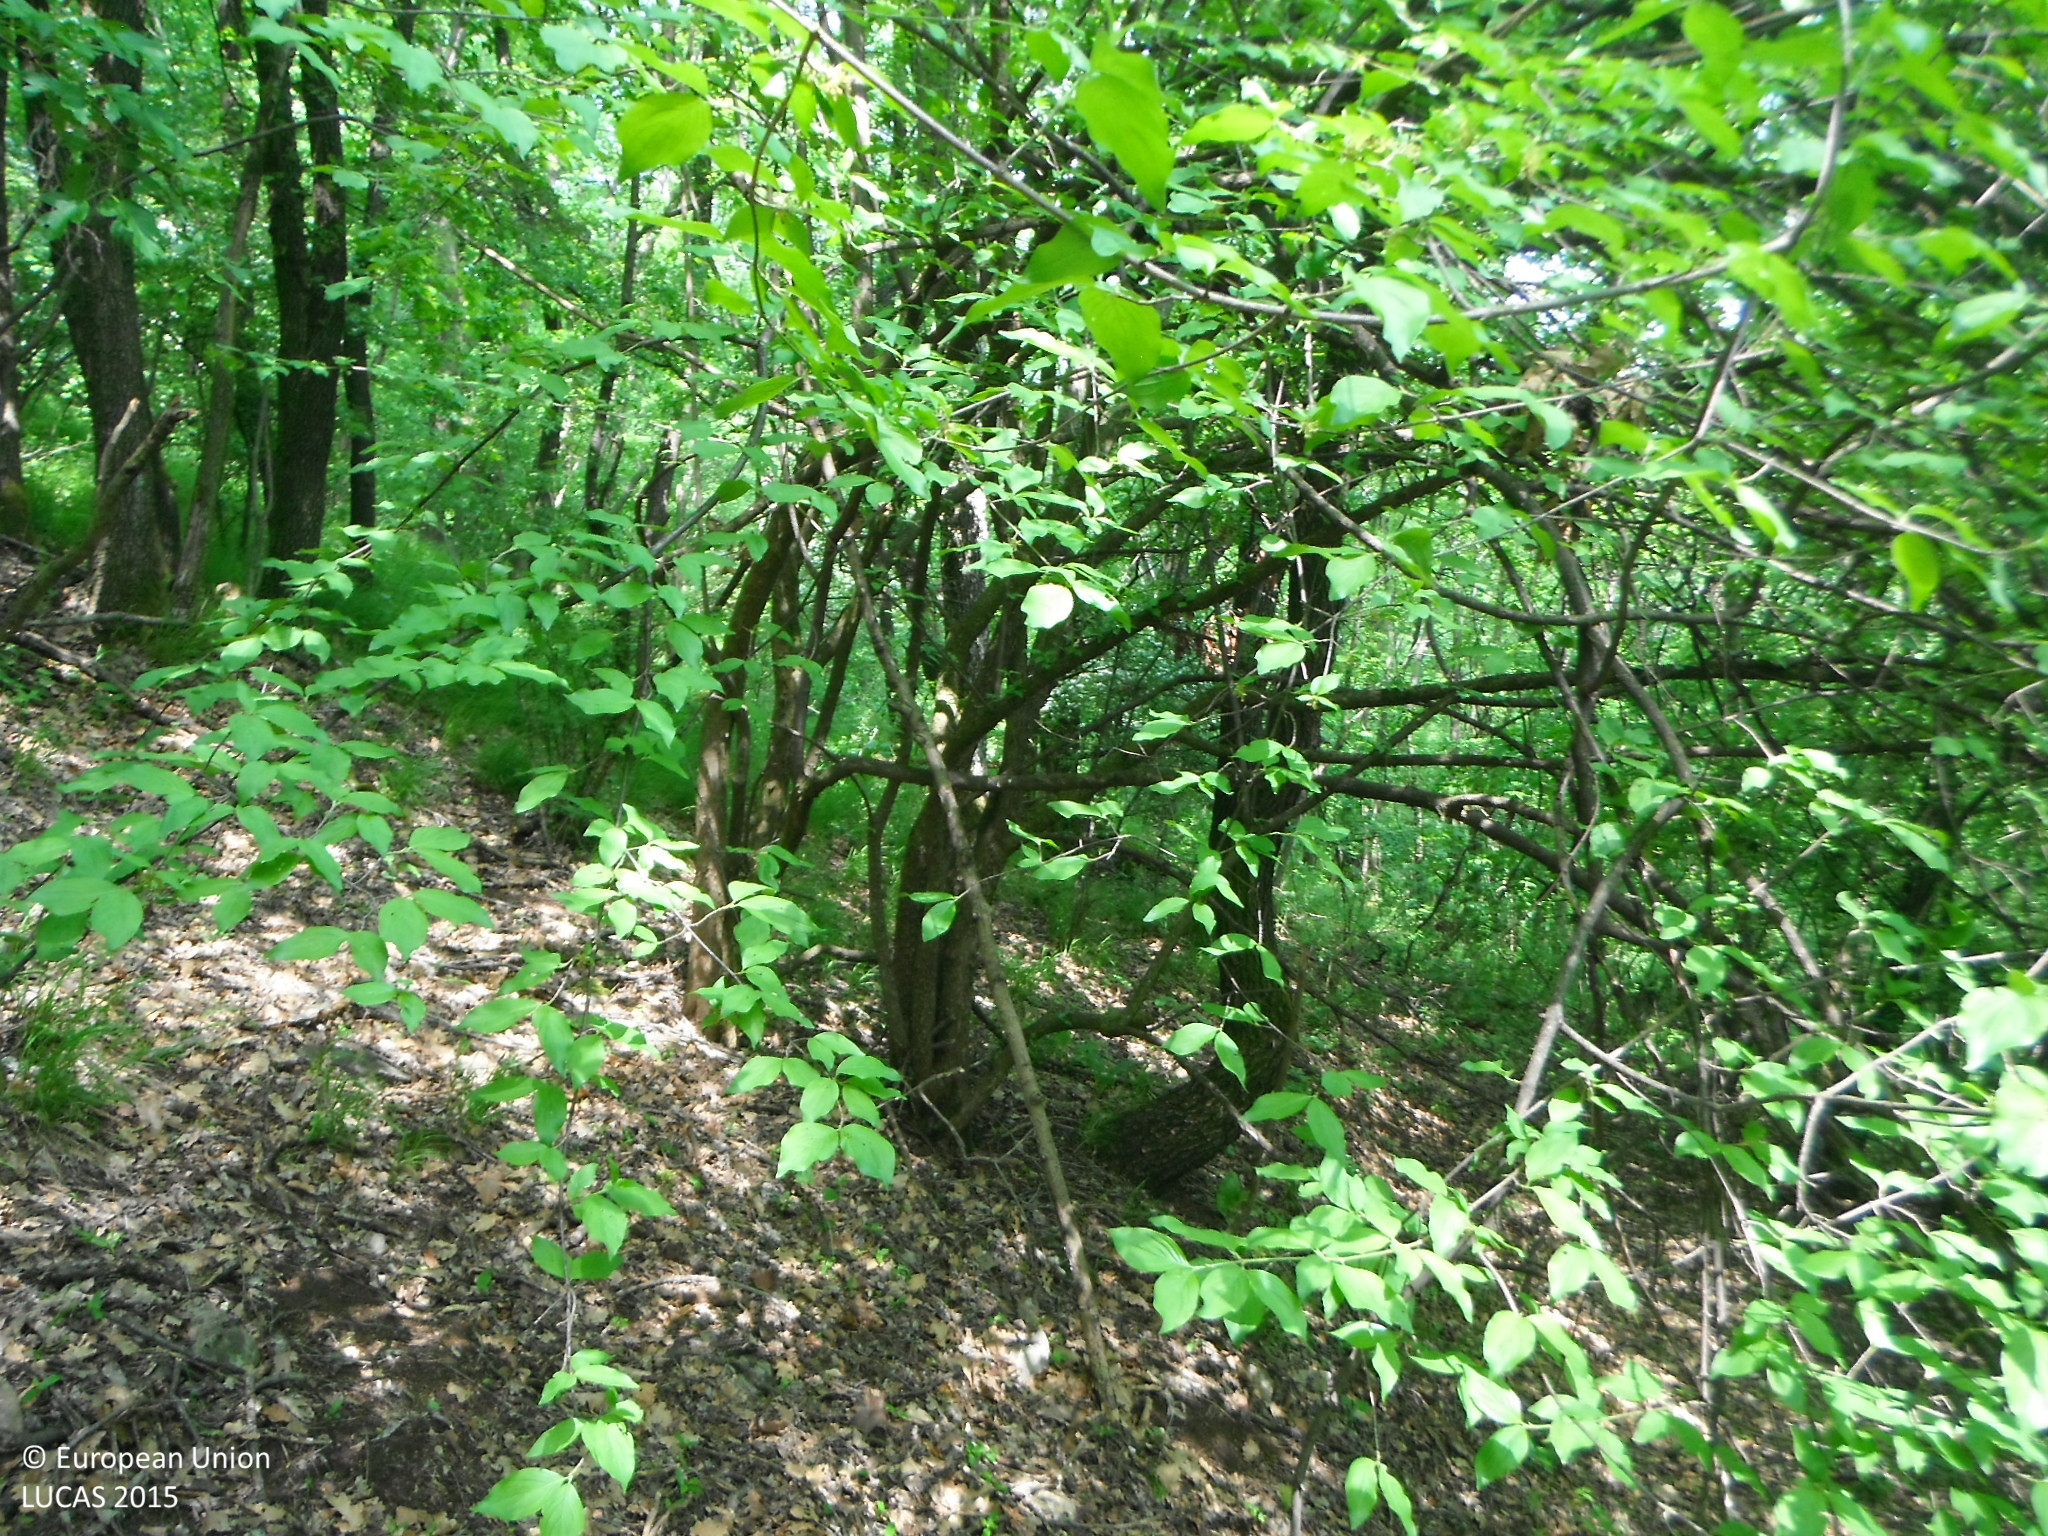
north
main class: Woodland
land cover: Broadleaved woodland
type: mesophytic deciduous forest
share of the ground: > 75 %
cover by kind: broadleaved forest trees 100 %
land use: Forestry
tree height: > 5 m
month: May
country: SK
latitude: 48.3593
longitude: 18.0982
